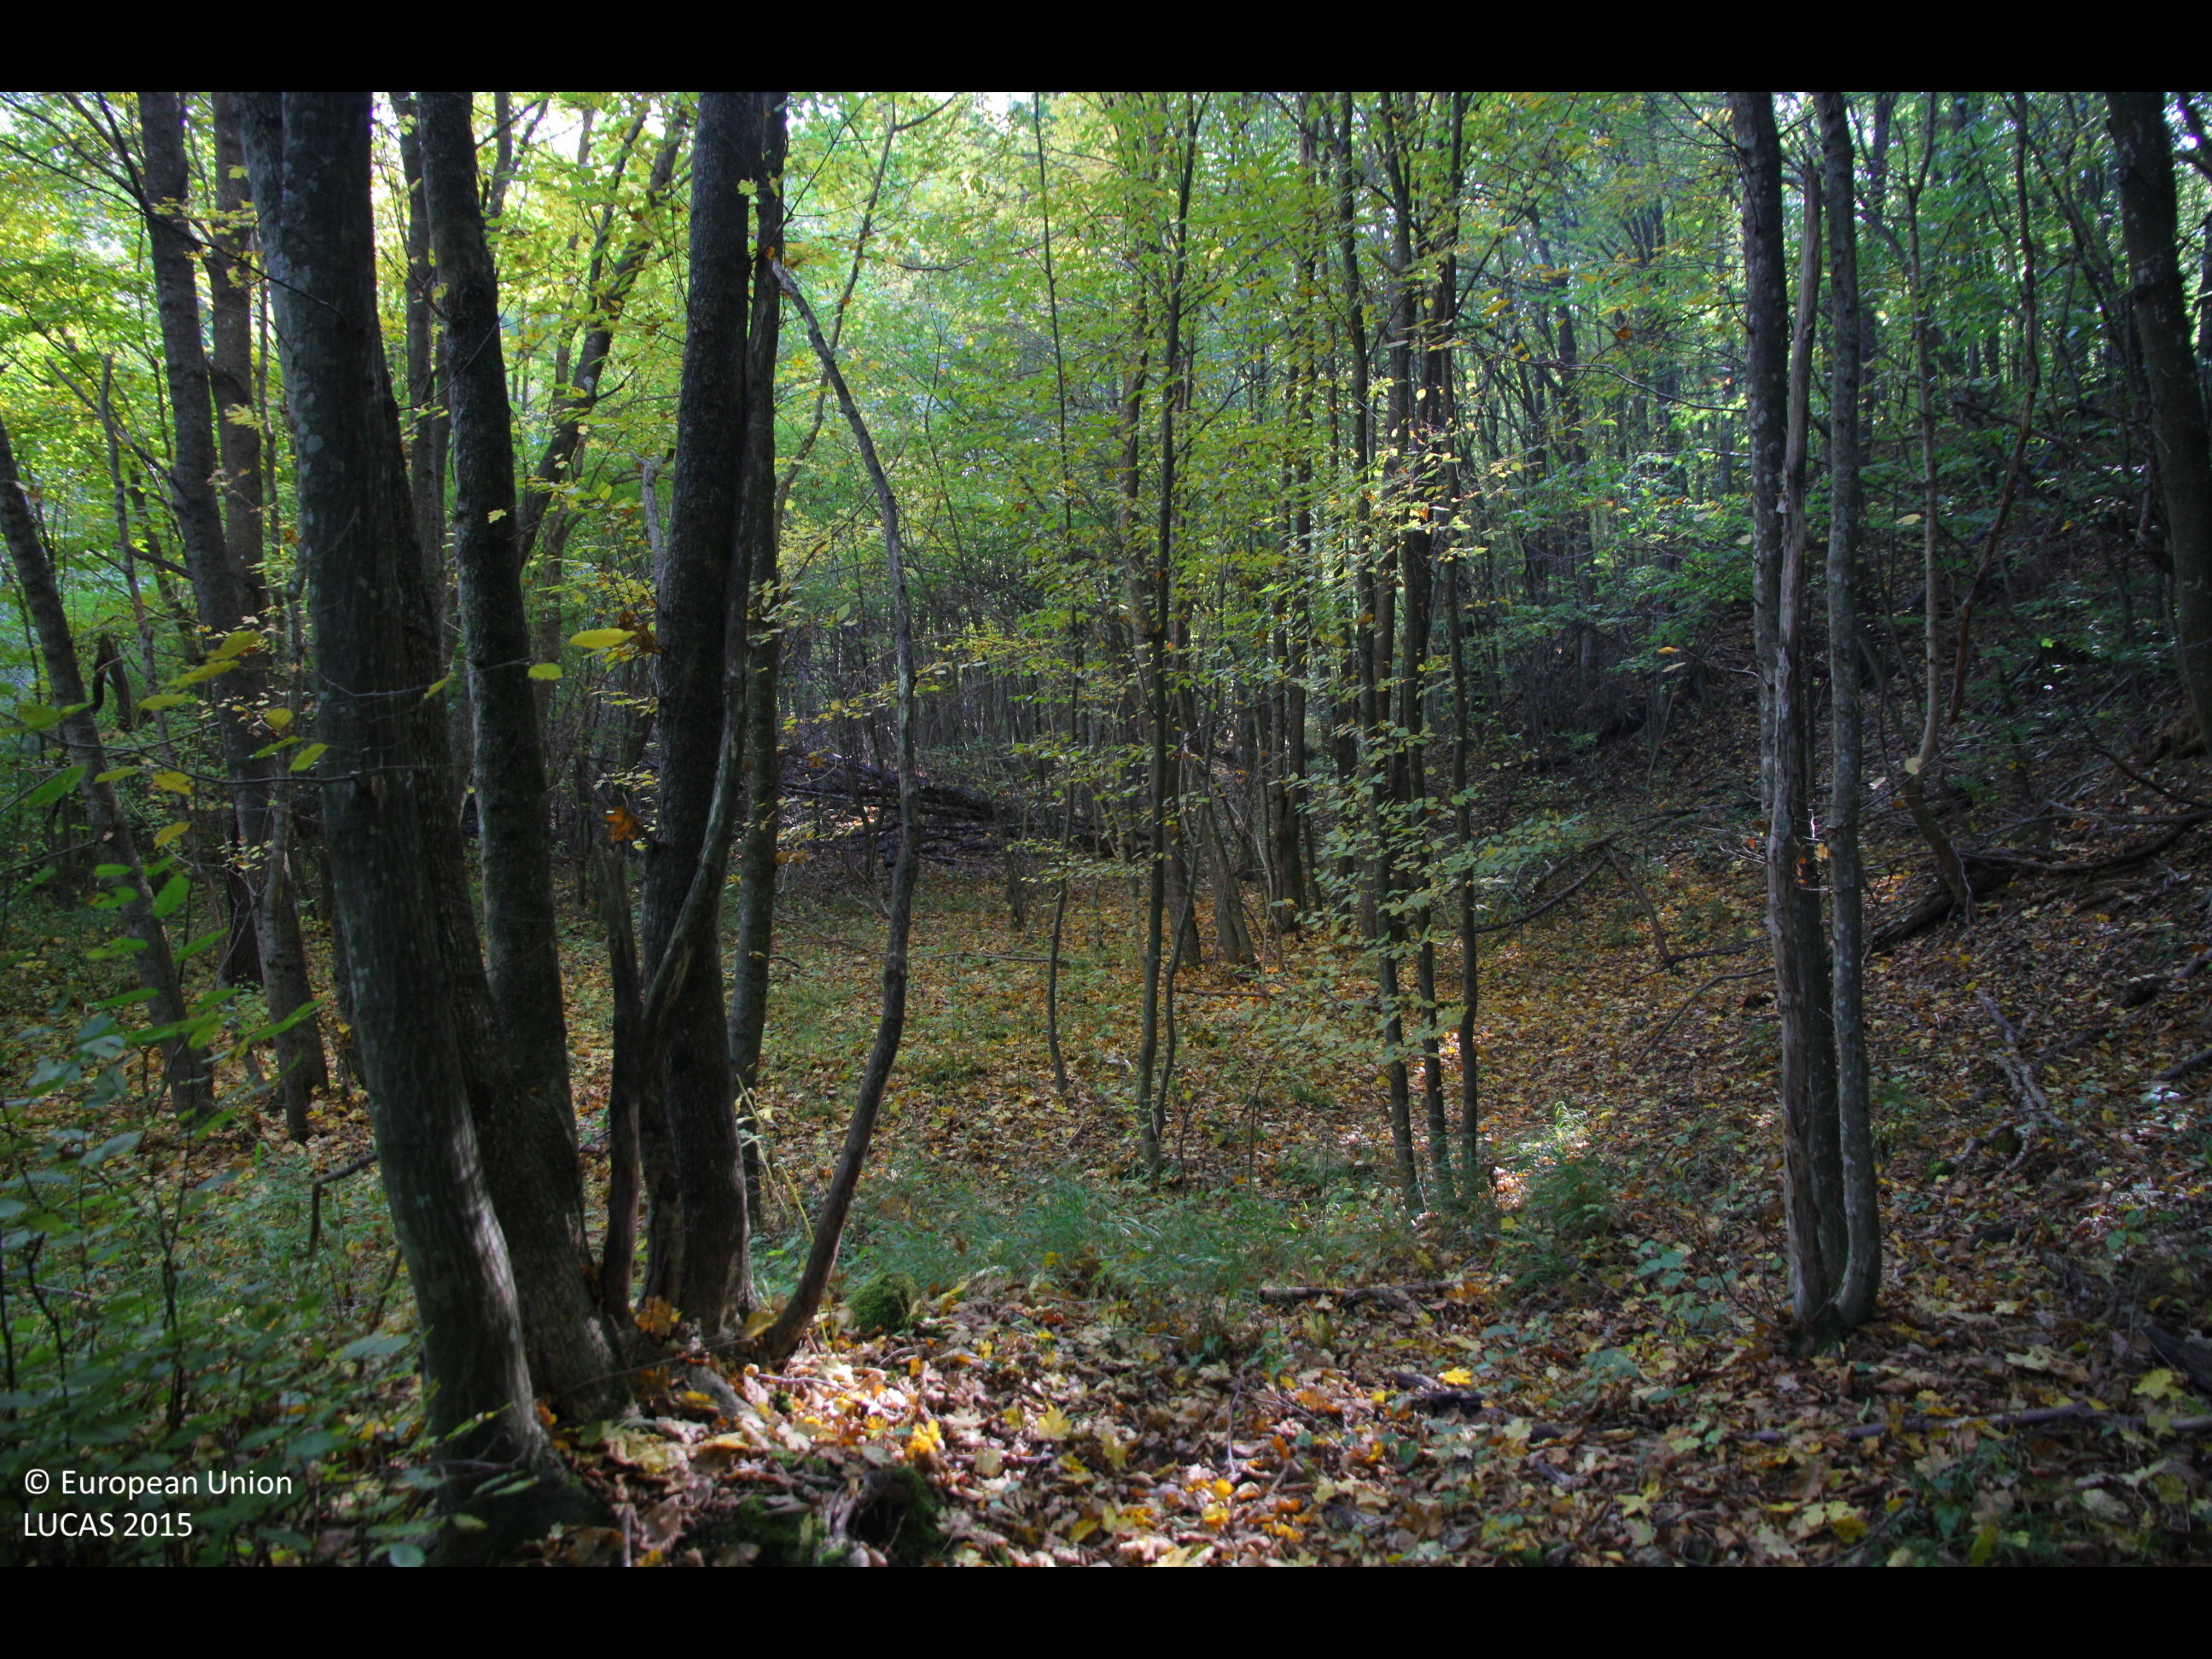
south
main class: Woodland
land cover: Broadleaved woodland
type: beech forest
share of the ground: > 75 %
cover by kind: broadleaved forest trees 100 %
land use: Forestry
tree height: > 5 m
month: October
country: BG
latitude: 42.9756
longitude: 26.8695
